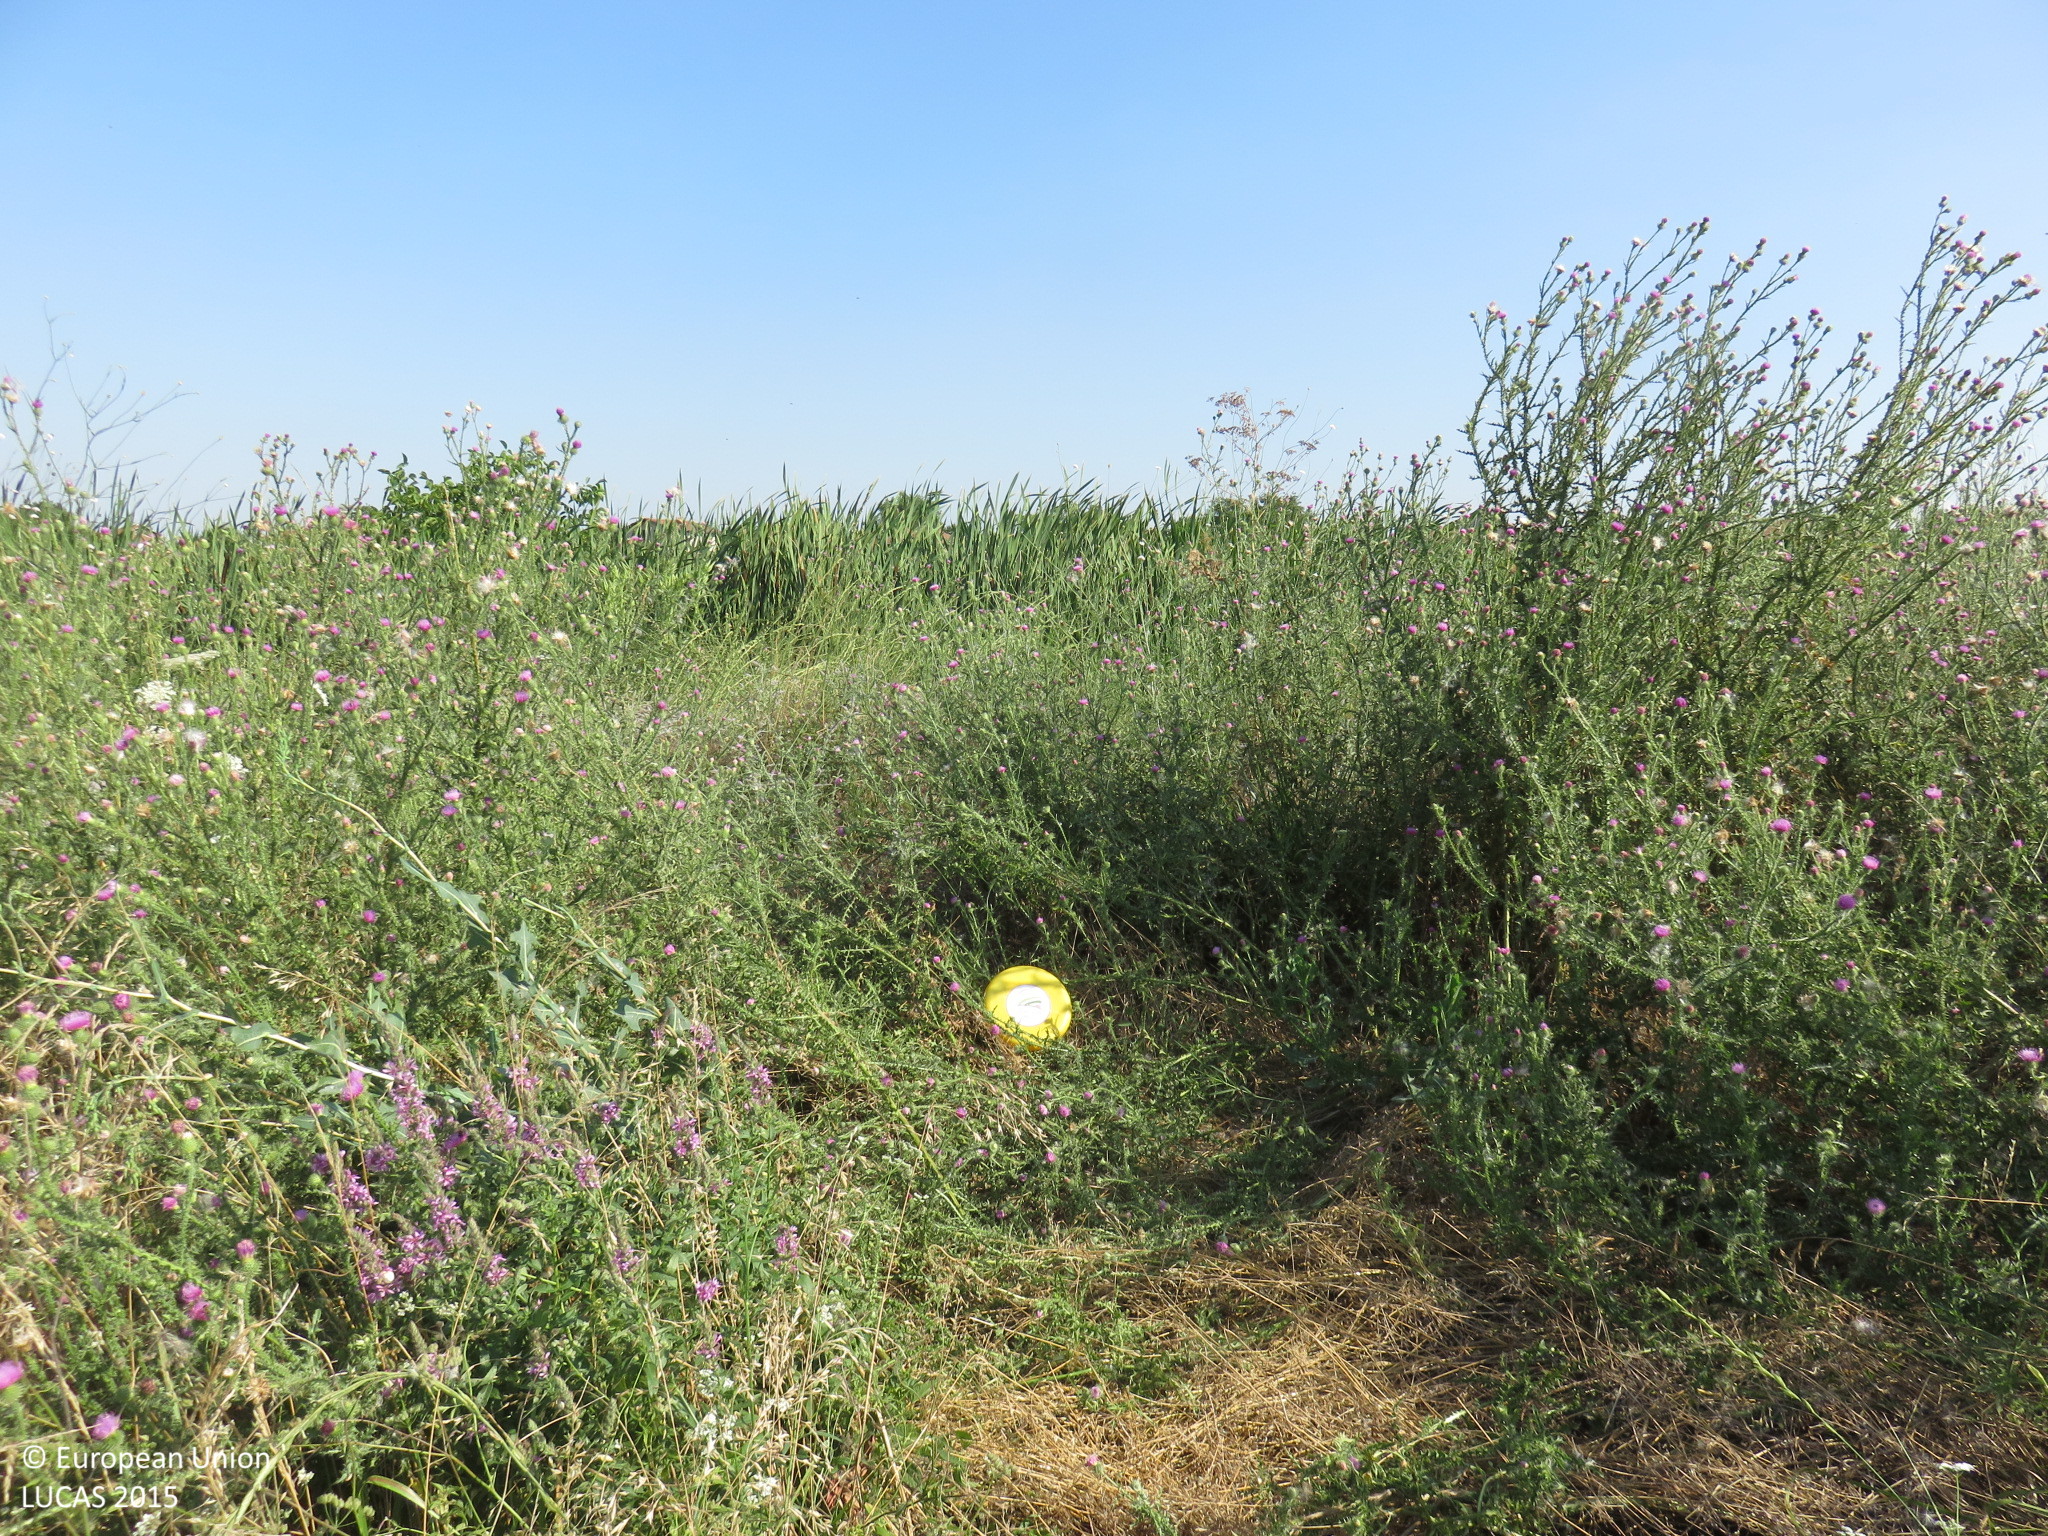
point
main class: Grassland
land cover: Grassland without tree/shrub cover
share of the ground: > 75 %
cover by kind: herbaceous plants 100 %
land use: Agriculture (excluding fallow land and kitchen gardens)
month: July
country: BG
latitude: 43.3994
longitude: 25.1236
